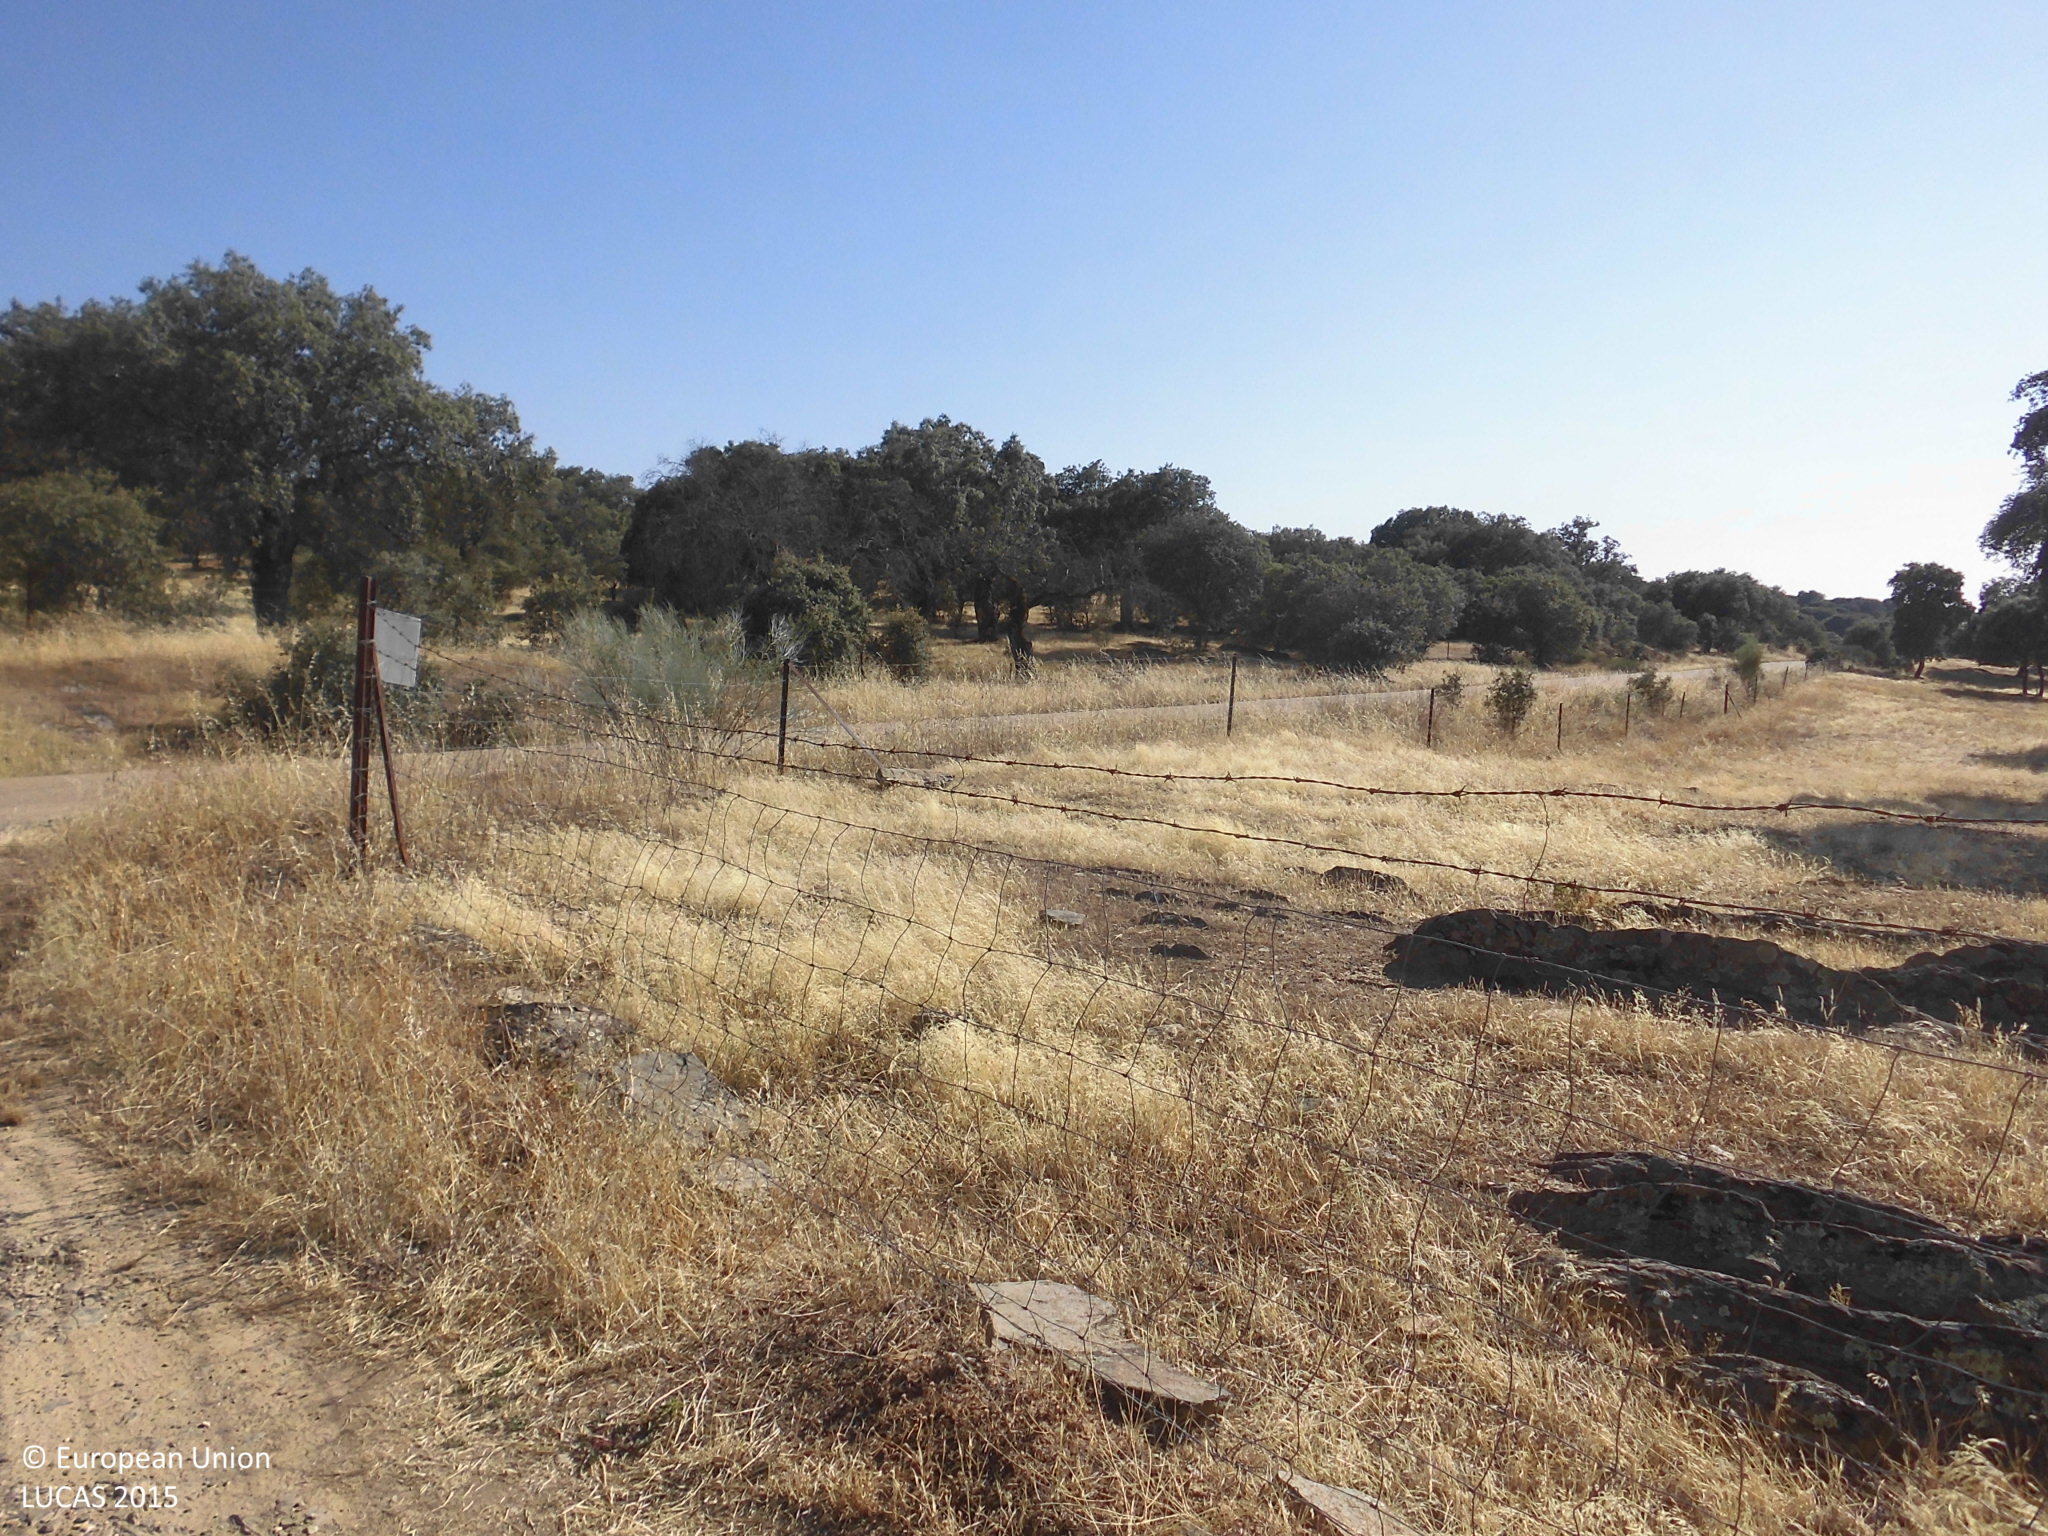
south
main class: Woodland
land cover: Broadleaved woodland
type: broadleaved evergreen forest
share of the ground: 10 - 25 %
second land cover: Grassland without tree/shrub cover
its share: > 75 %
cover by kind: herbaceous plants 80 %, broadleaved forest trees 20 %
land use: Forestry
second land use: Agriculture (excluding fallow land and kitchen gardens)
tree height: > 5 m
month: July
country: ES
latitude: 39.5636
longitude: -5.5934
